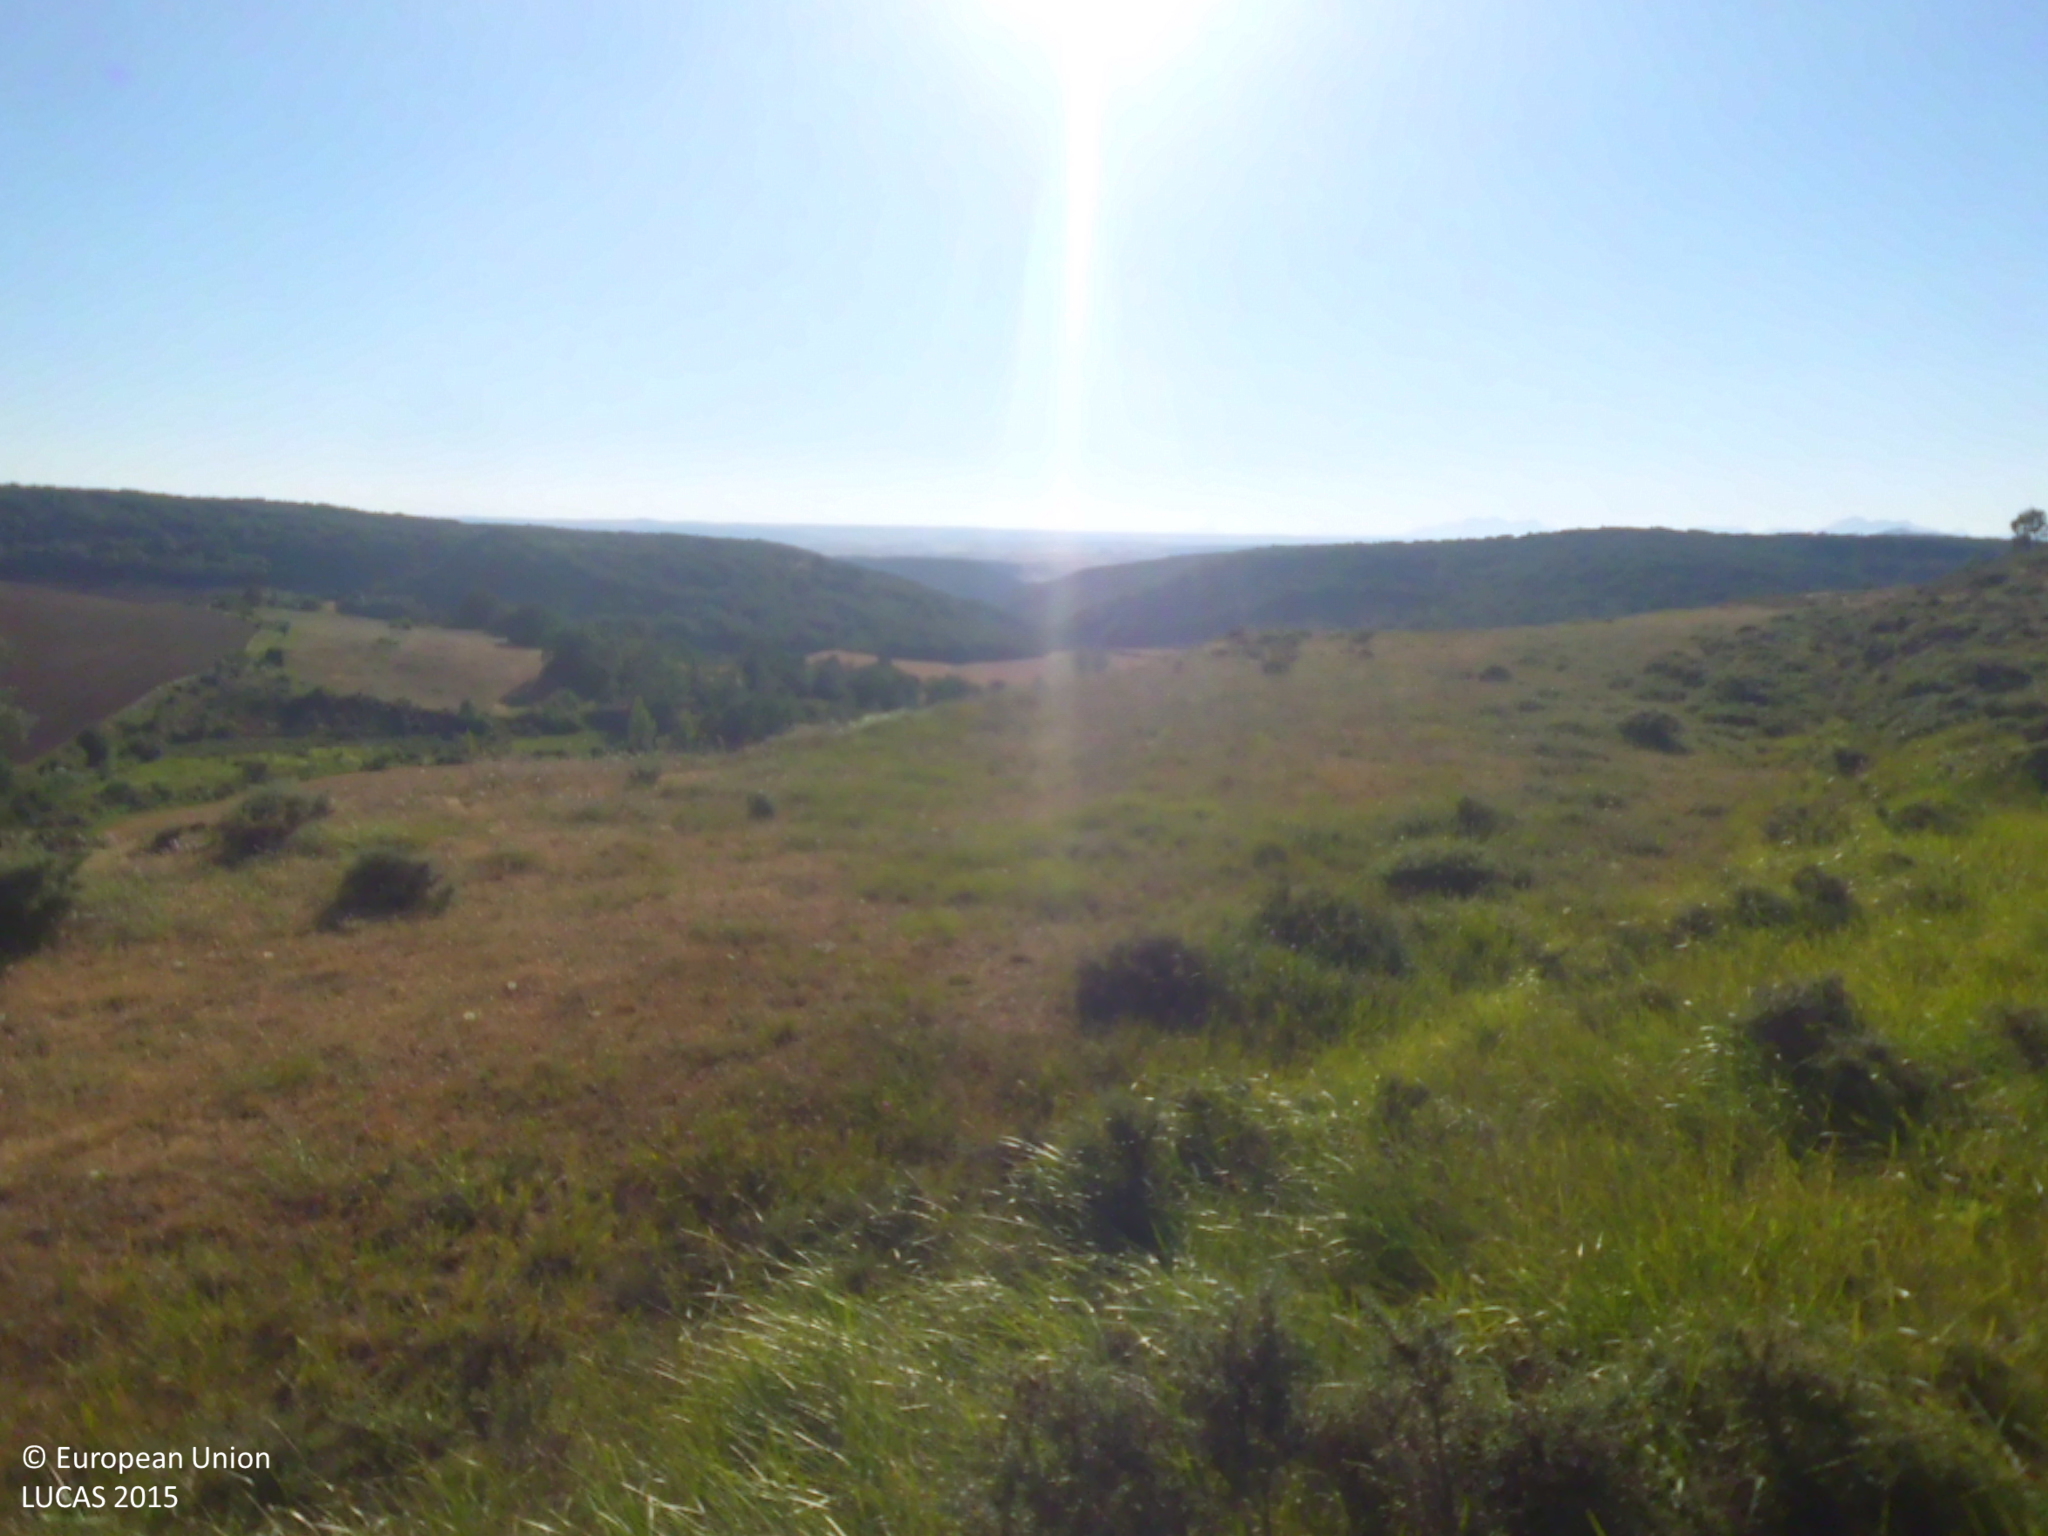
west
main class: Shrubland
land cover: Shrubland without tree cover
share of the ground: 50 - 75 %
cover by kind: shrubs 65 %, consolidated bare surface 20 %, herbaceous plants 15 %
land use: Abandoned areas
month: July
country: ES
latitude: 42.6641
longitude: -4.2623
